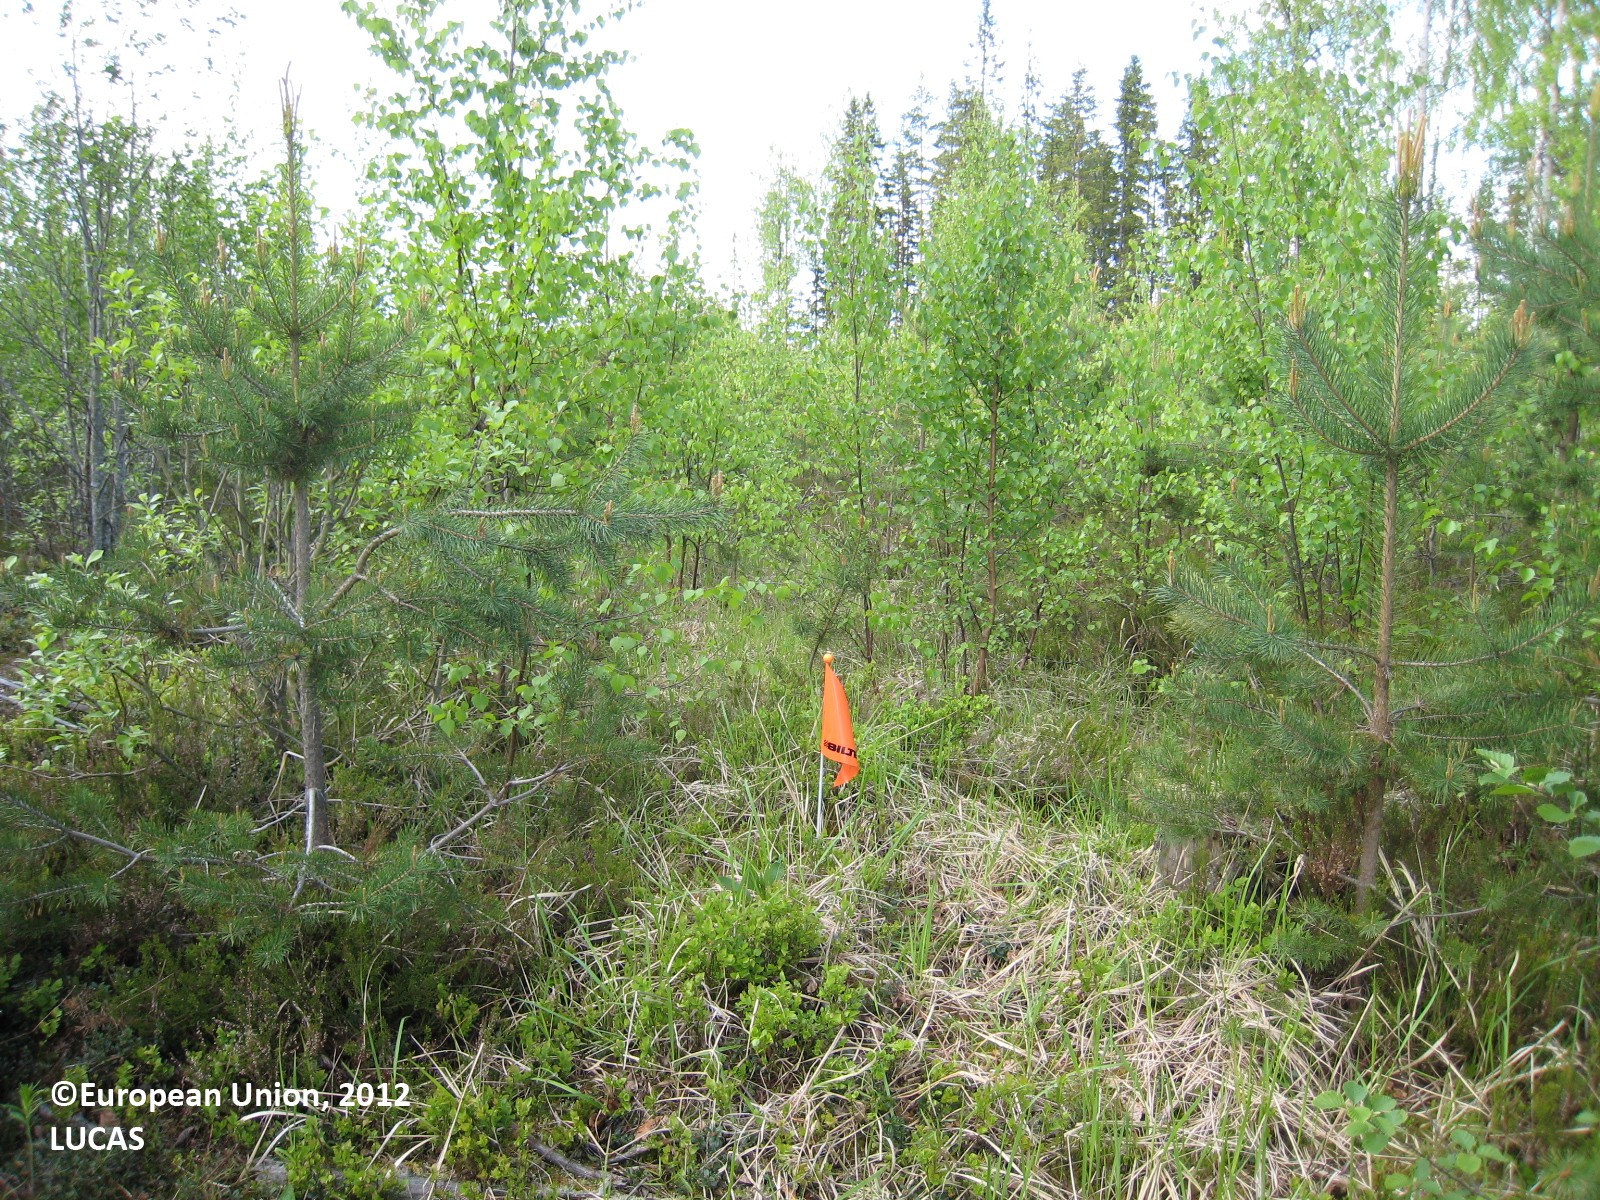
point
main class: Woodland
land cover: Pine dominated mixed woodland
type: boreal forest
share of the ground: 50 - 75 %
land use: Forestry
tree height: < 5 m
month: June
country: FI
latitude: 62.7086
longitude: 25.6550
